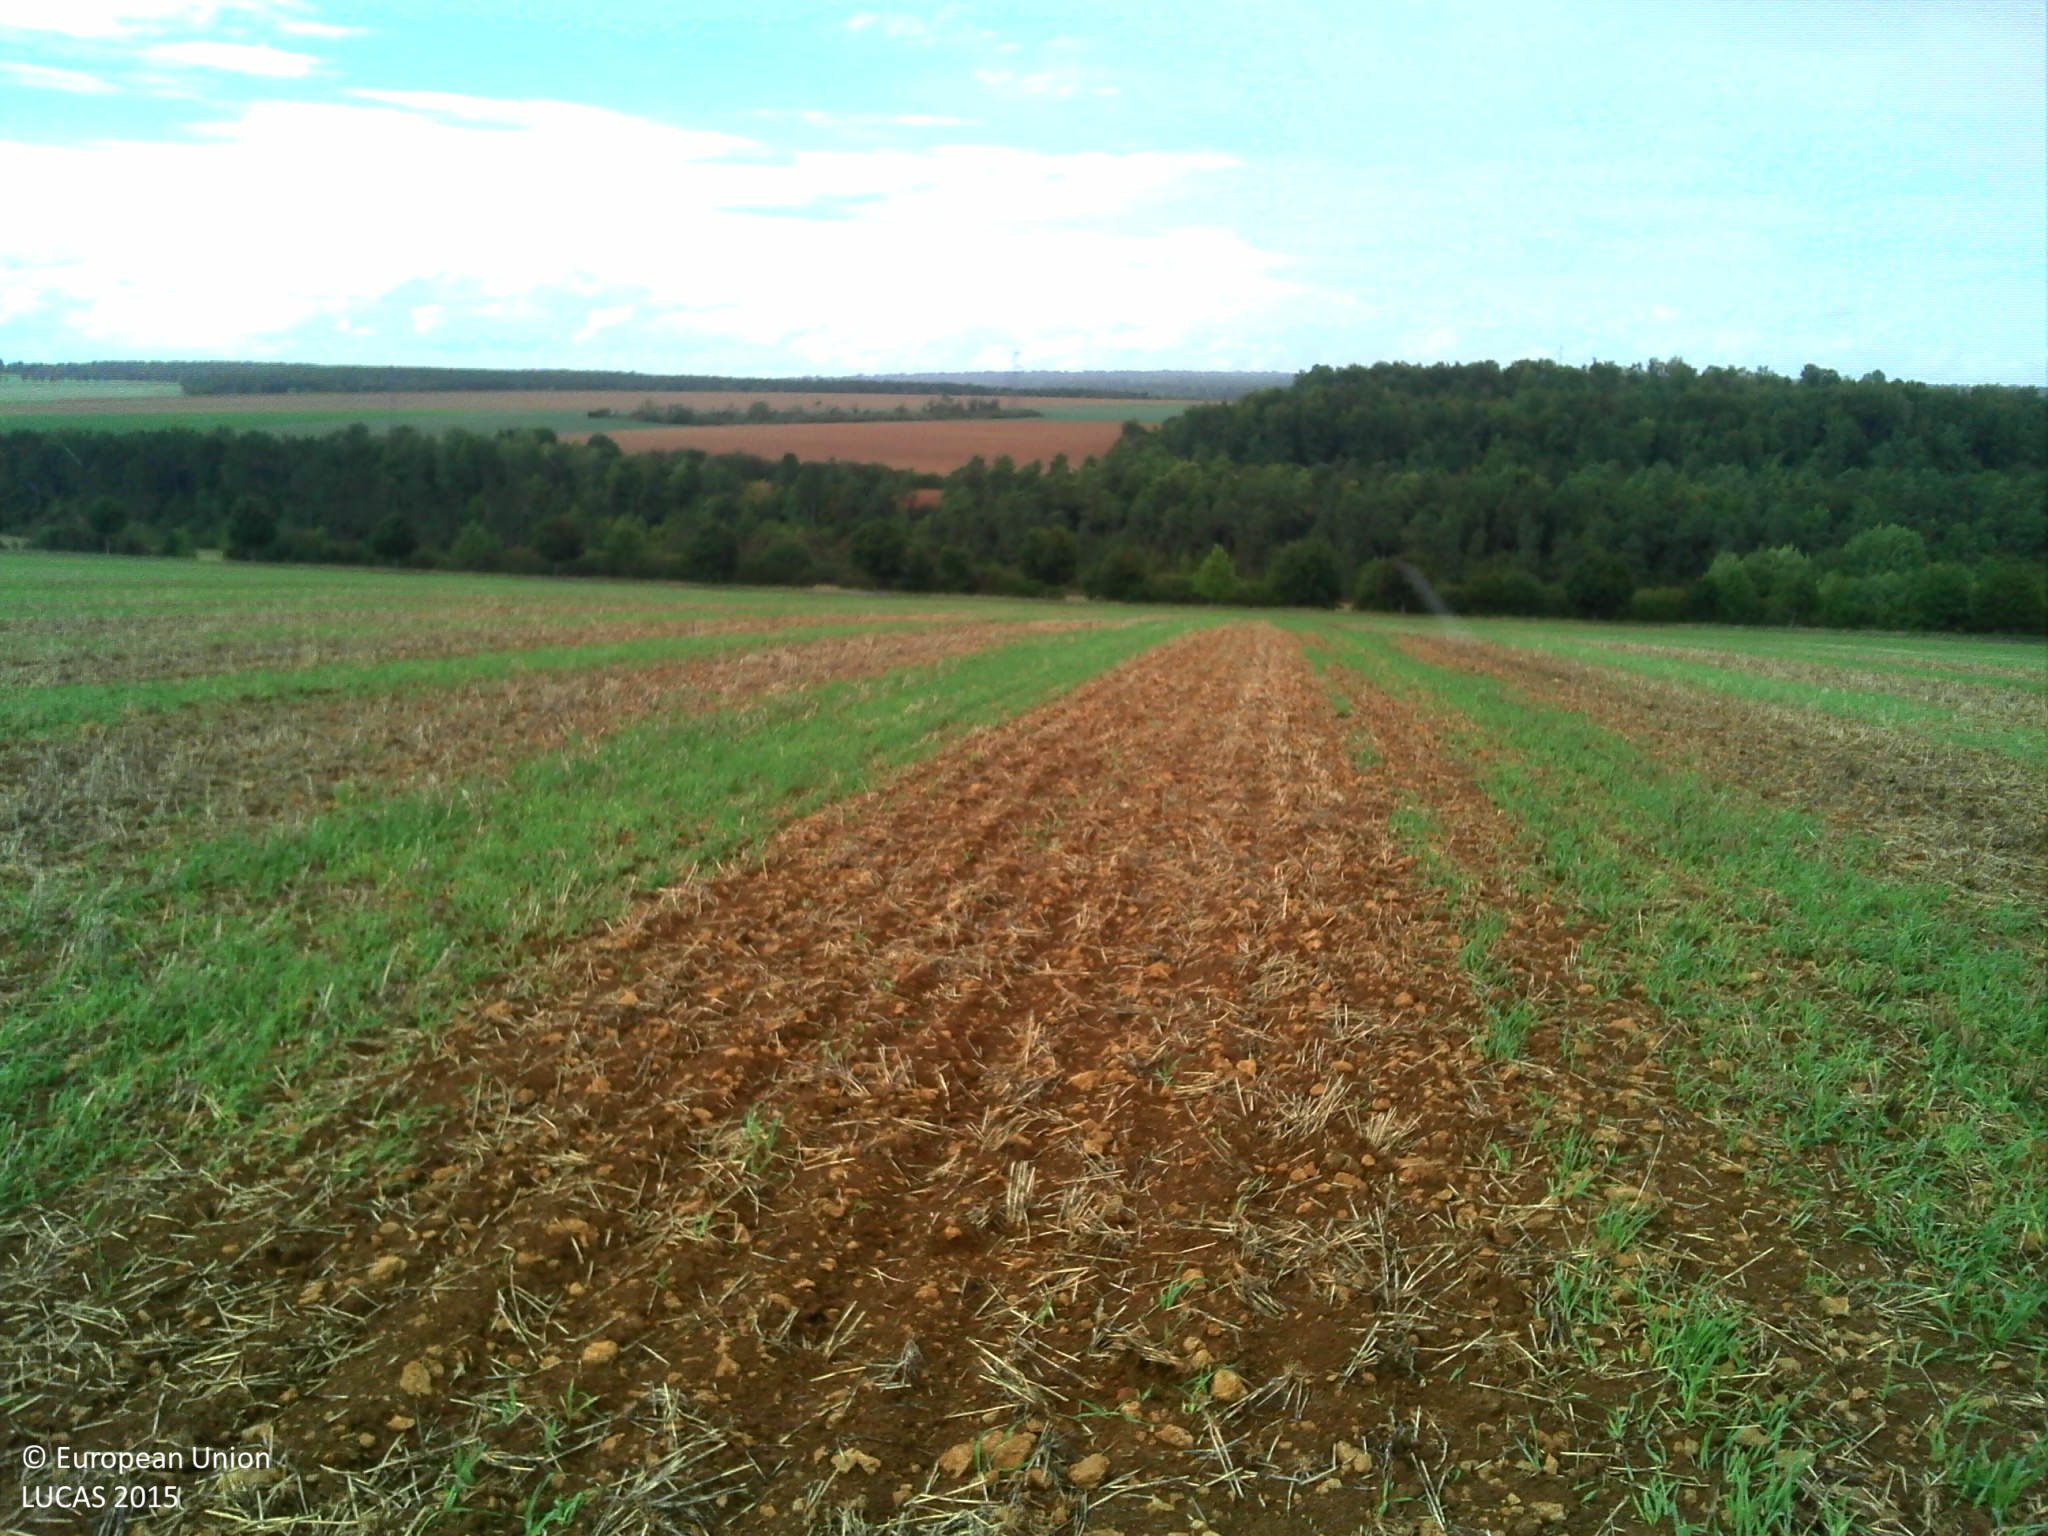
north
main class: Cropland
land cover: Common wheat
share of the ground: < 10 %
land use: Agriculture (excluding fallow land and kitchen gardens)
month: September
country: FR
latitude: 48.8867
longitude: 5.9218
